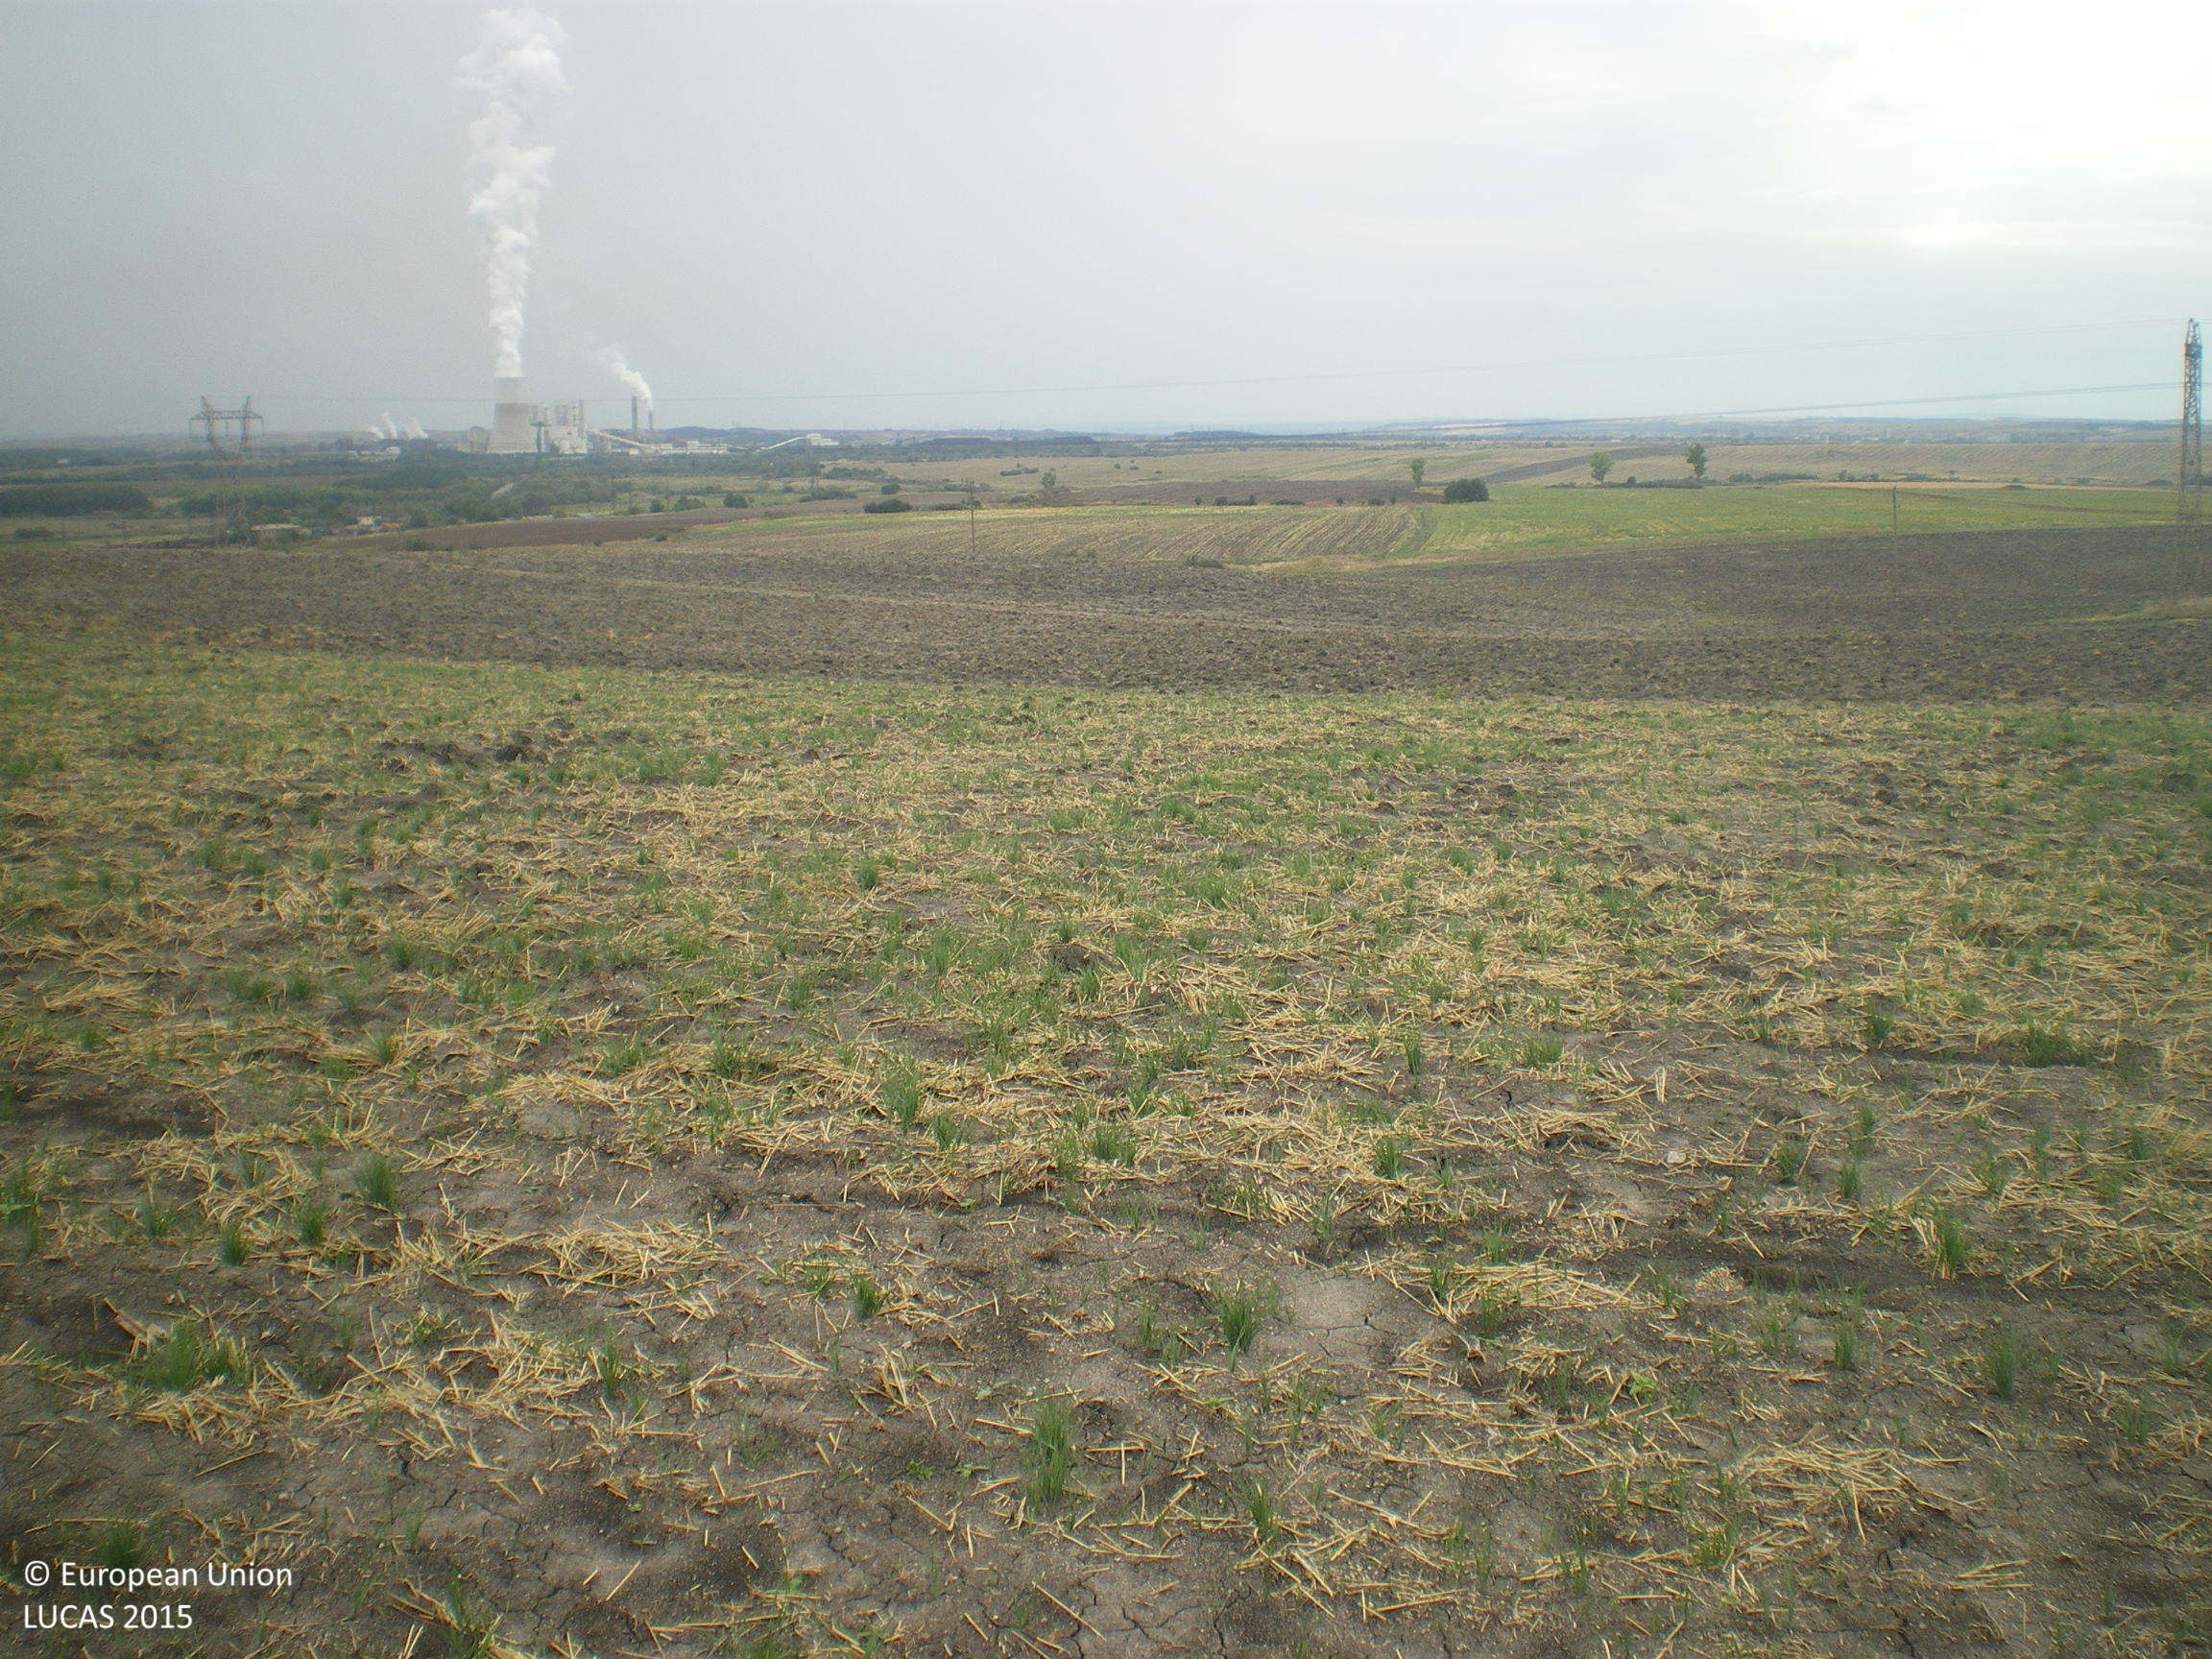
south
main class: Cropland
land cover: Common wheat
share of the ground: < 10 %
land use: Agriculture (excluding fallow land and kitchen gardens)
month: September
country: BG
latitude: 42.1965
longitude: 25.9028
